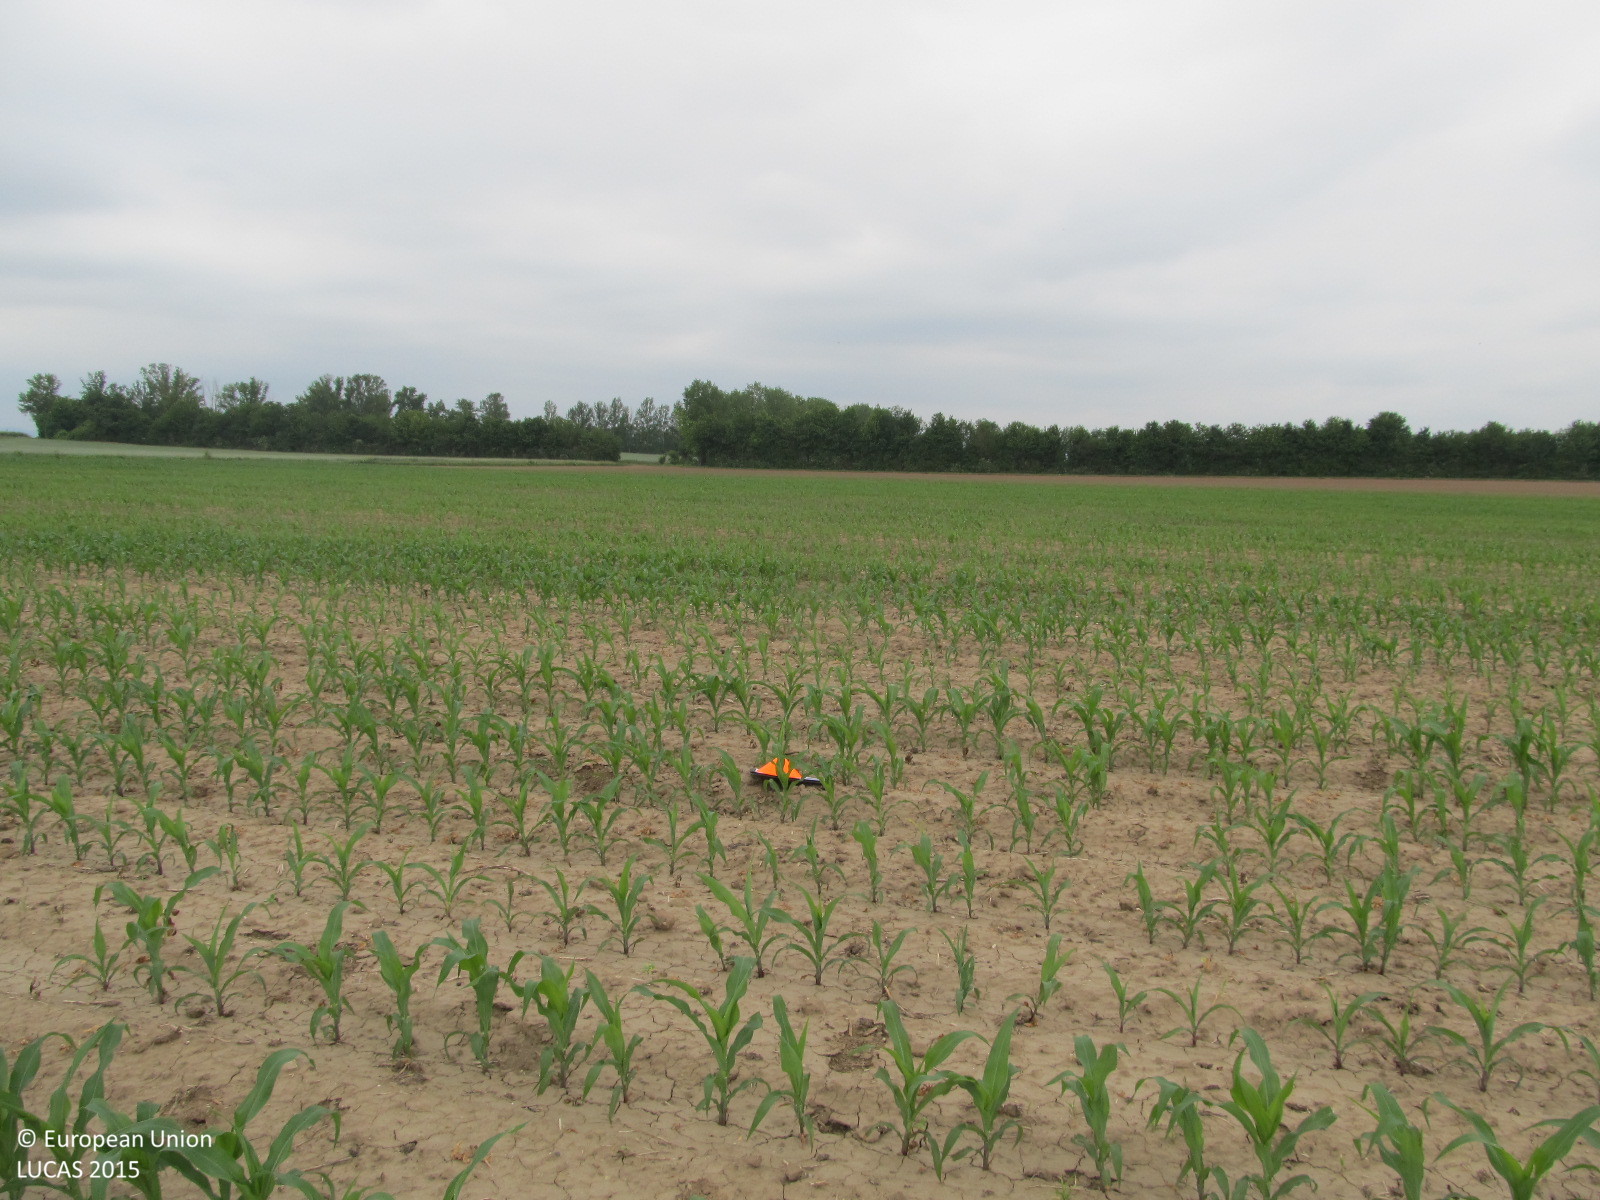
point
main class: Cropland
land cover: Maize
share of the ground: < 10 %
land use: Agriculture (excluding fallow land and kitchen gardens)
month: June
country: AT
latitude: 48.4399
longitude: 15.6400
